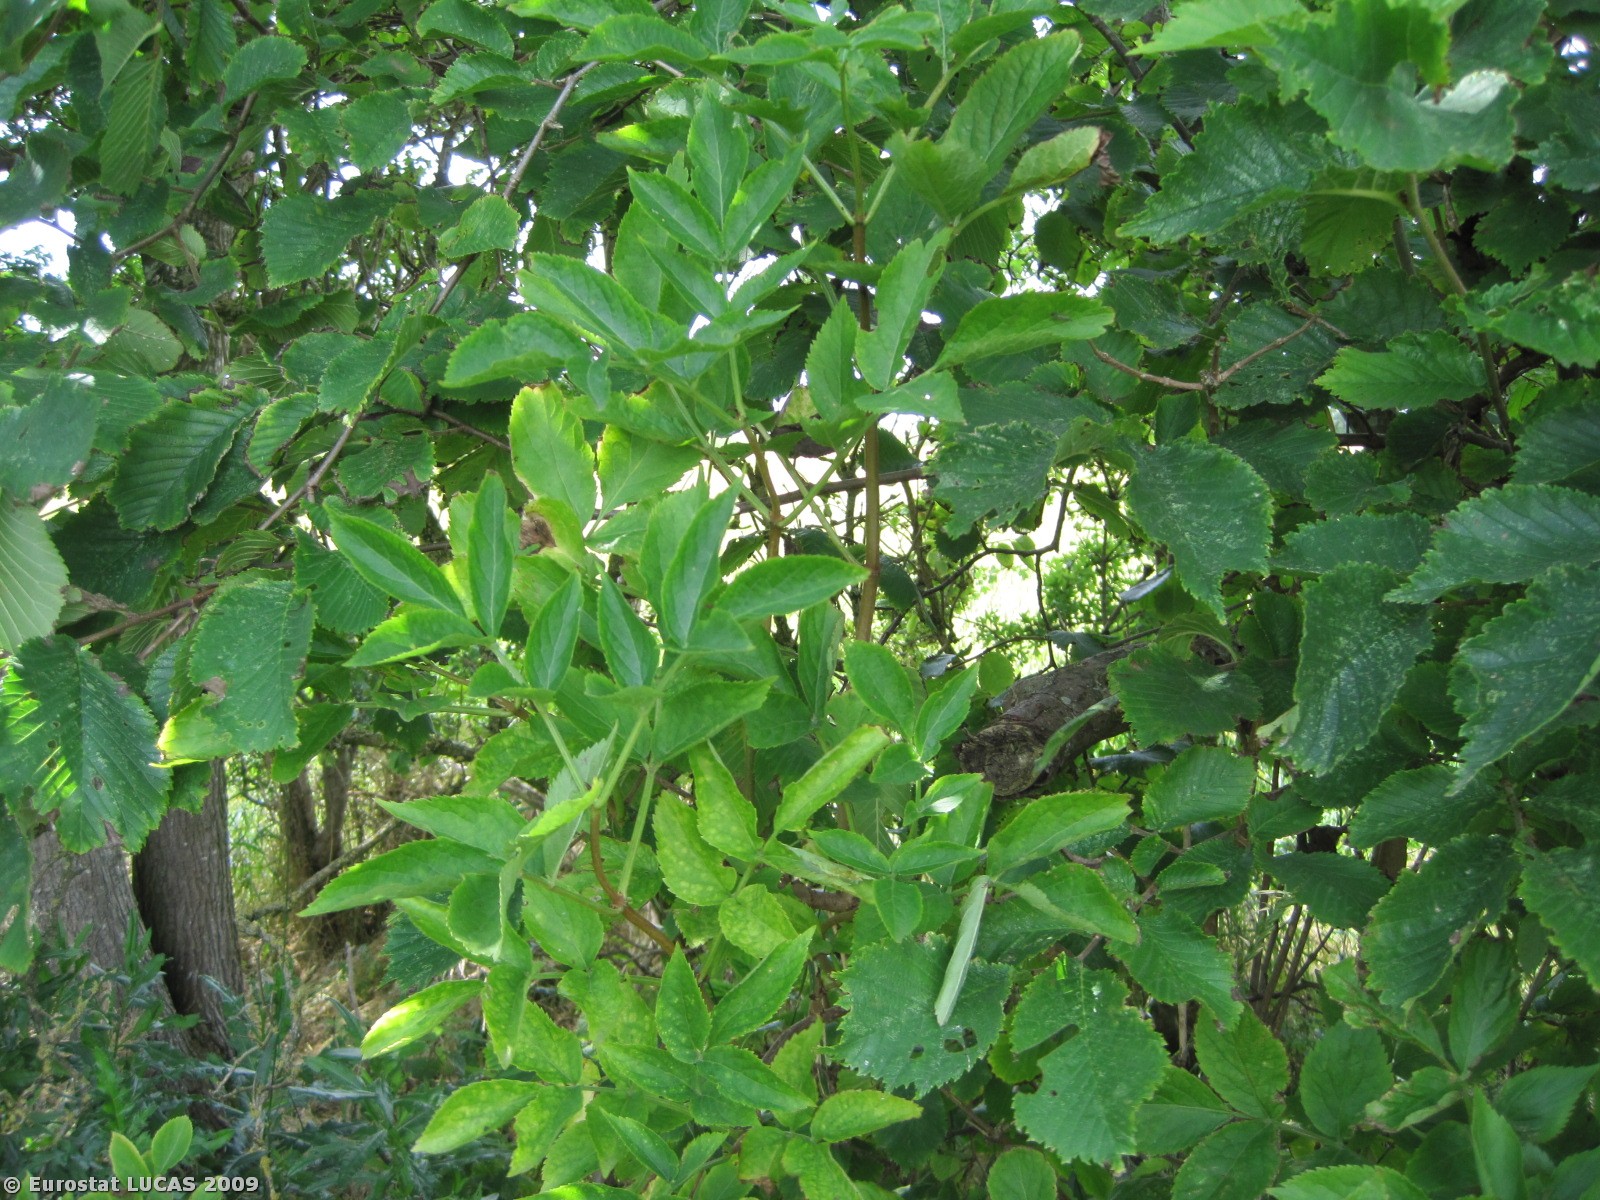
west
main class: Woodland
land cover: Broadleaved woodland
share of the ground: > 75 %
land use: Forestry
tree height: > 5 m
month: July
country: DK
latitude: 57.0269
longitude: 8.7662
